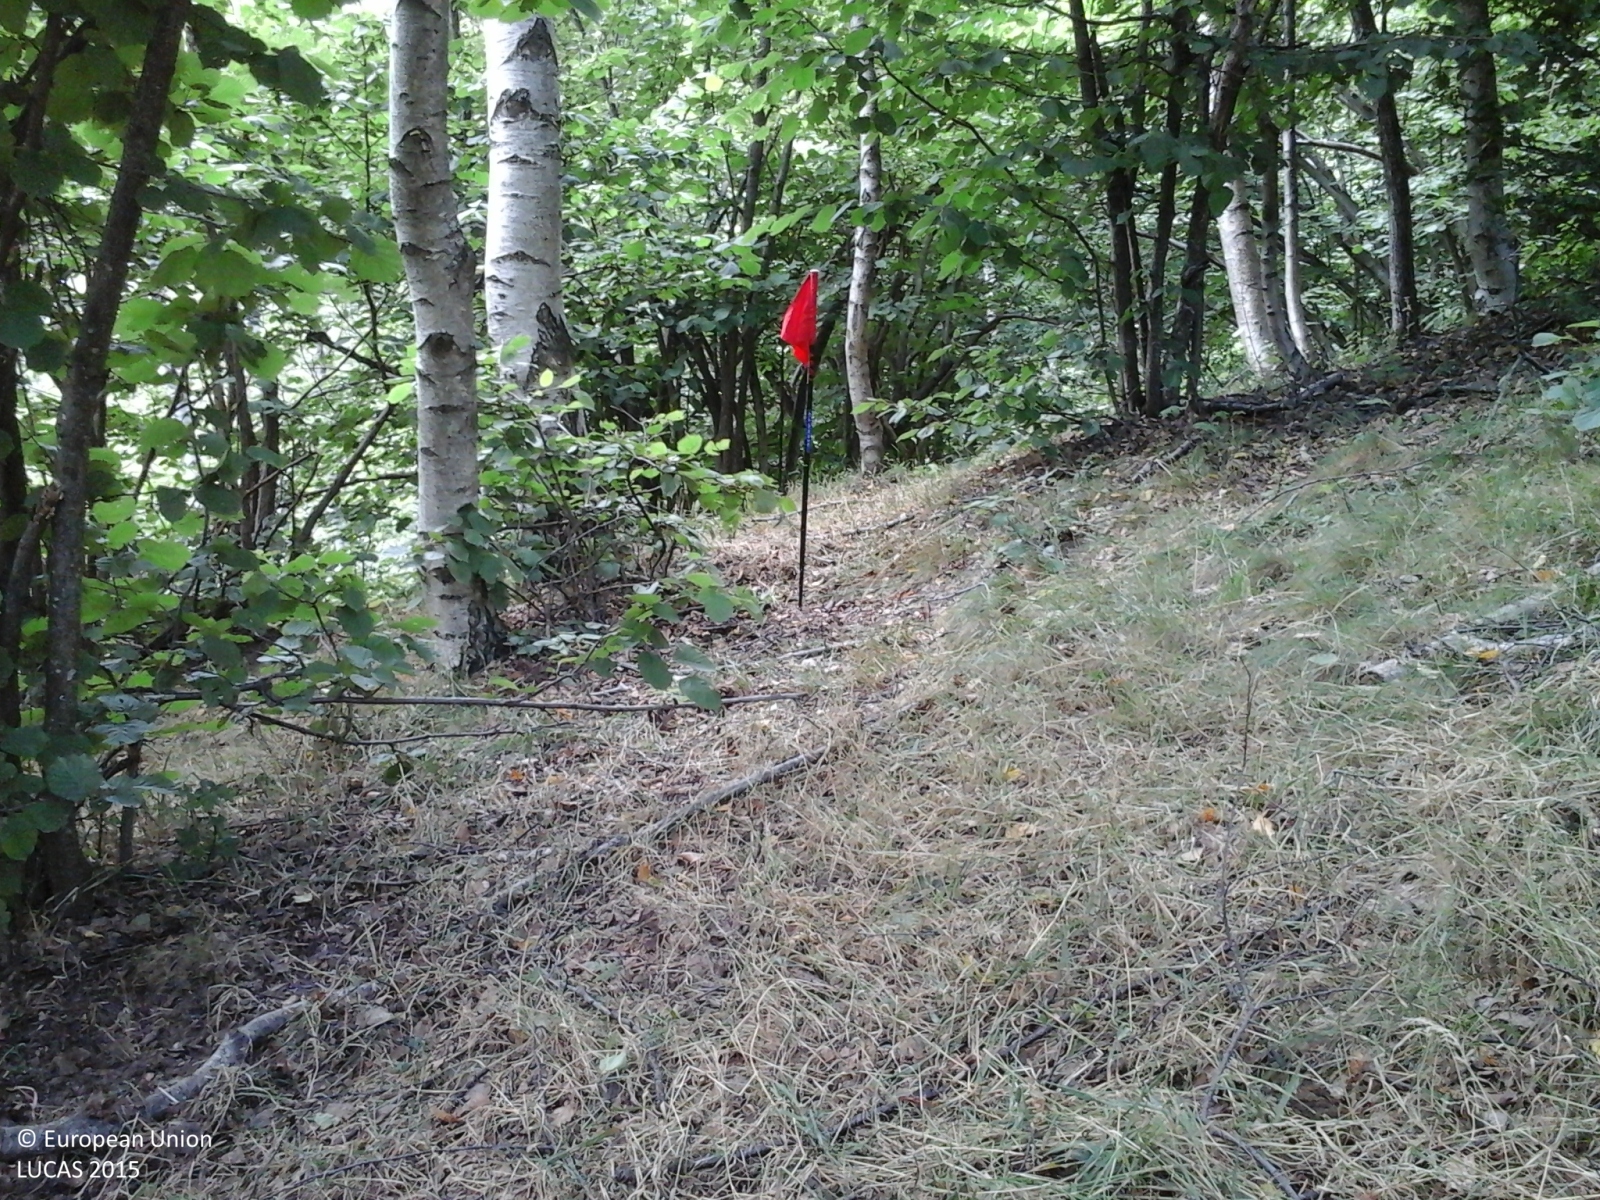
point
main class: Woodland
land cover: Broadleaved woodland
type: mountainous beech forest
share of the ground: > 75 %
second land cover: Grassland without tree/shrub cover
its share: > 75 %
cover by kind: broadleaved forest trees 70 %, herbaceous plants 30 %
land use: Forestry
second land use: Agriculture (excluding fallow land and kitchen gardens)
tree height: > 5 m
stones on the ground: < 10 %
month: July
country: IT
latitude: 44.6741
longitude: 7.2174
